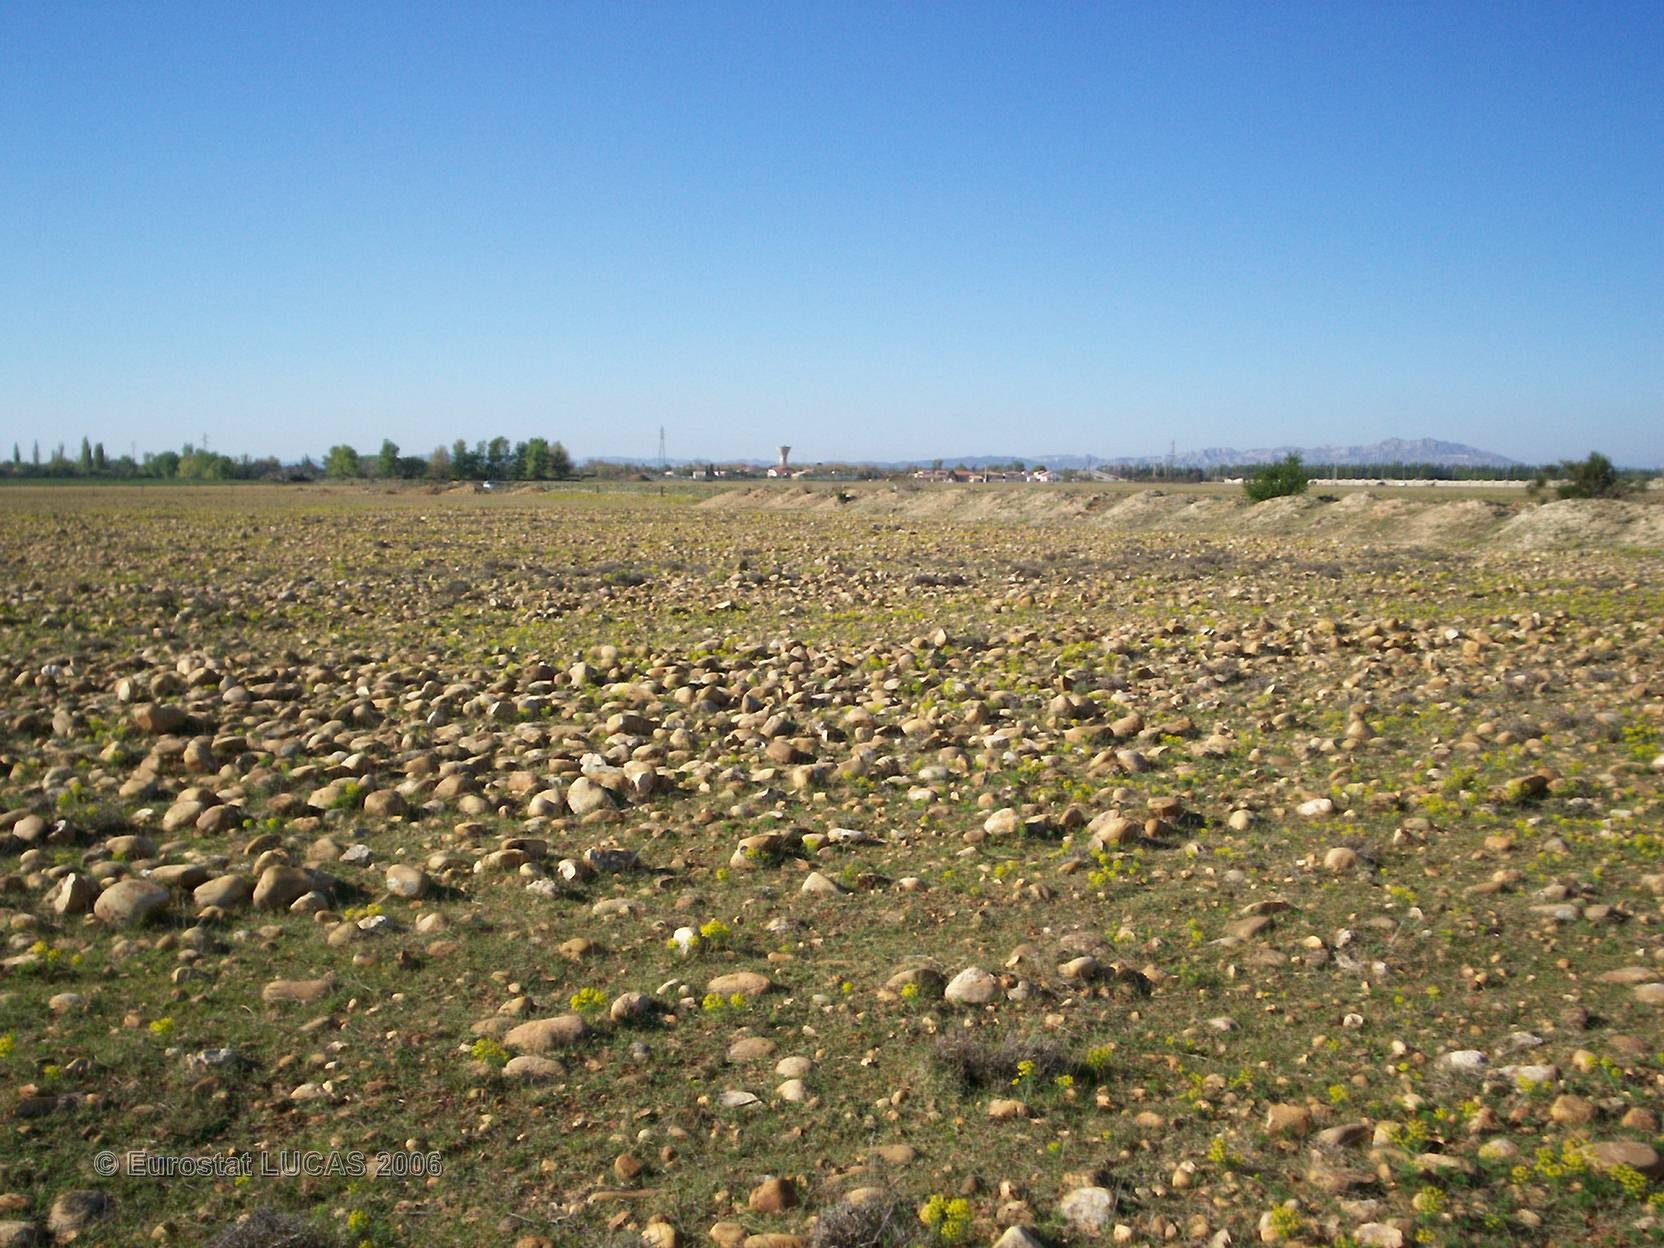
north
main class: Bare land
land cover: Bare land
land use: Unused
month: April
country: FR
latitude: 43.5767
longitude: 4.9450
